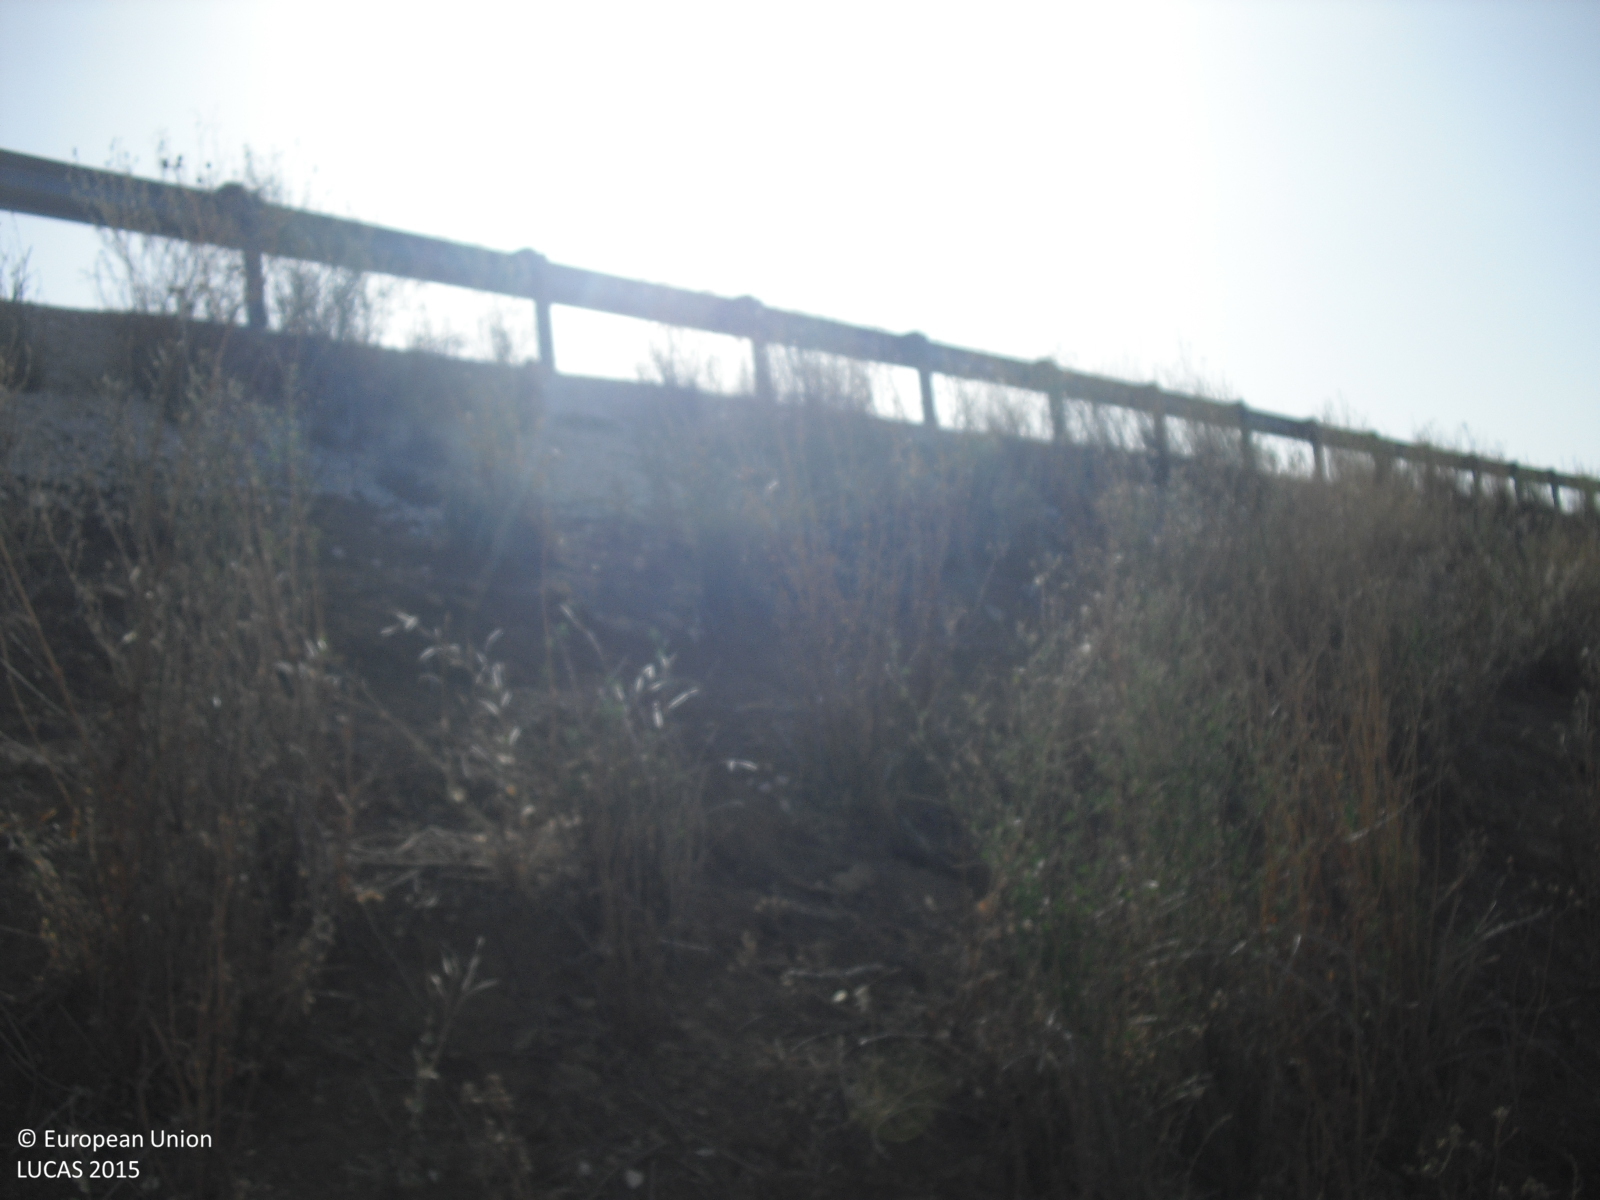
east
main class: Grassland
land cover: Grassland without tree/shrub cover
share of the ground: 25 - 50 %
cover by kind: unconsolidated bare surface 65 %, herbaceous plants 35 %
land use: Protection infrastructures
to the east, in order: Grassland without tree/shrub cover; Paved roads, cycling and walking lanes; Grassland without tree/shrub cover; Ditches and canals; Tracks; Grassland without tree/shrub cover; Abandoned hedges; Olive groves; Tracks; Grassland without tree/shrub cover; Fences; Grassland without tree/shrub cover; Tracks
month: July
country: ES
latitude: 37.1381
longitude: -4.3040
